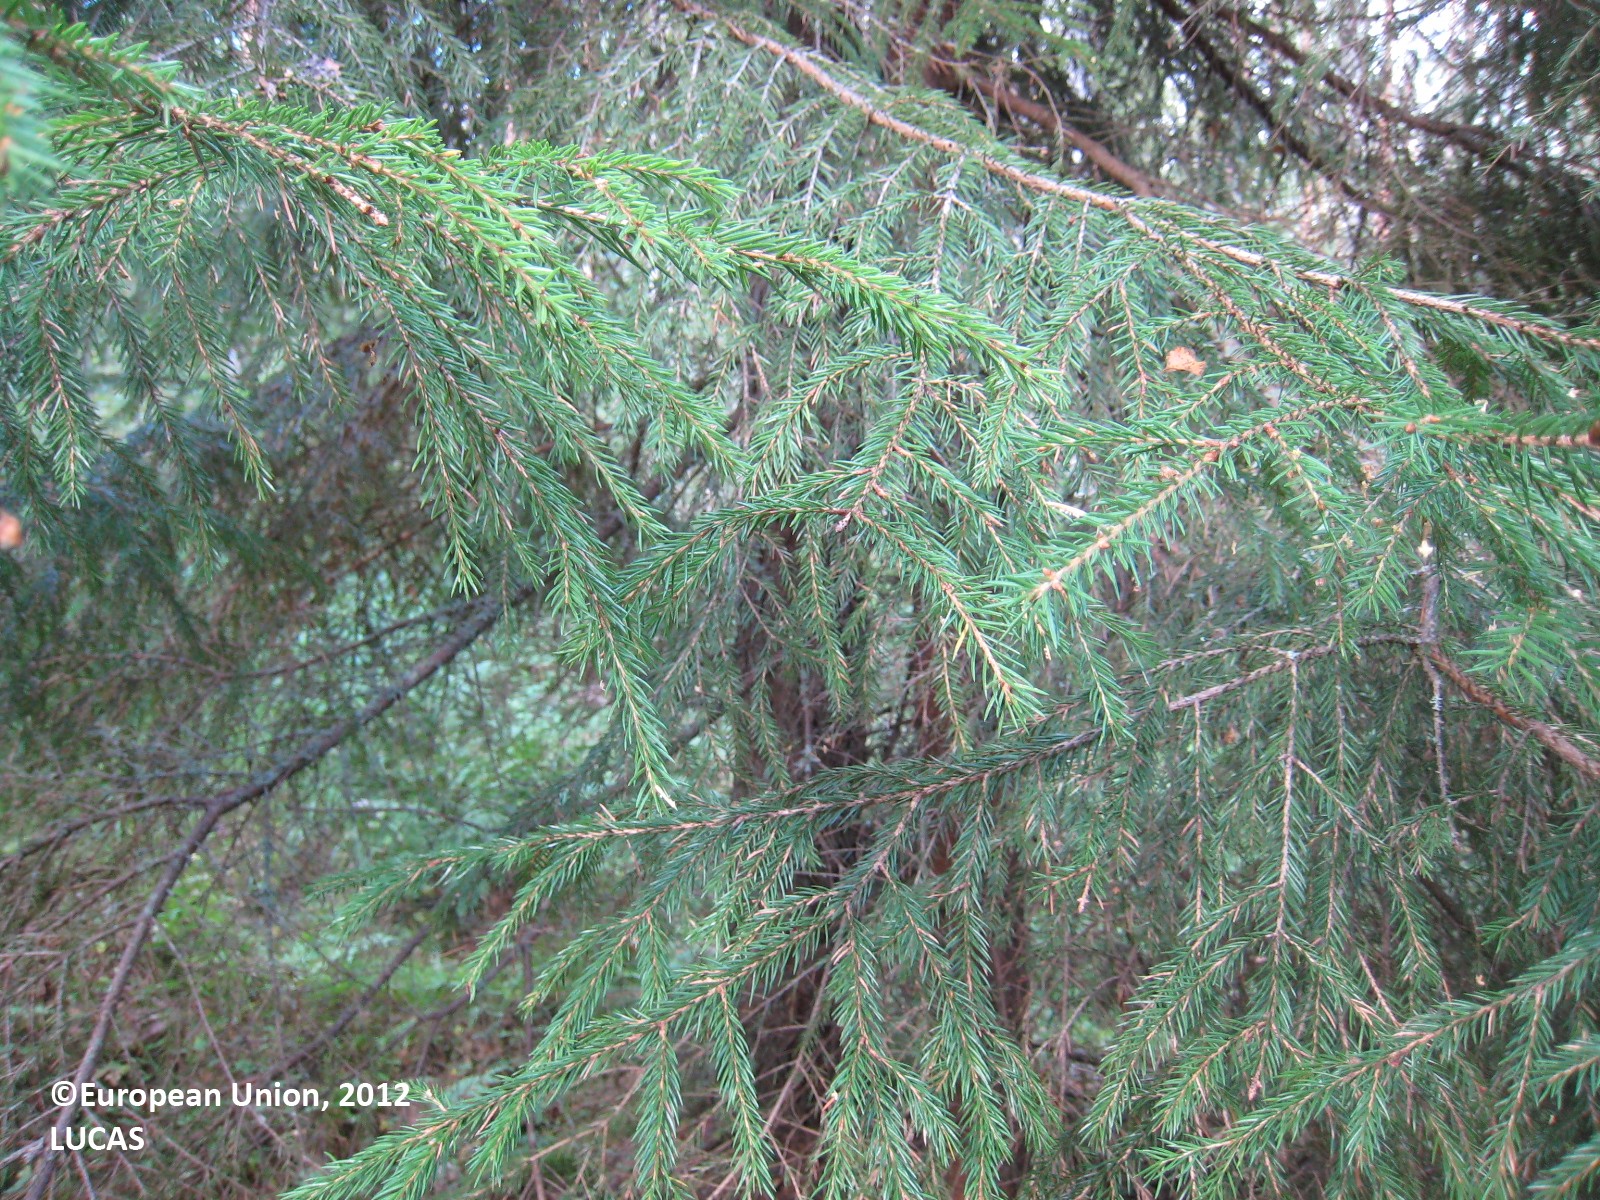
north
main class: Woodland
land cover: Other mixed woodland
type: boreal forest
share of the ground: > 75 %
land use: Forestry
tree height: > 5 m
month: August
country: FI
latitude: 62.0285
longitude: 27.2700
